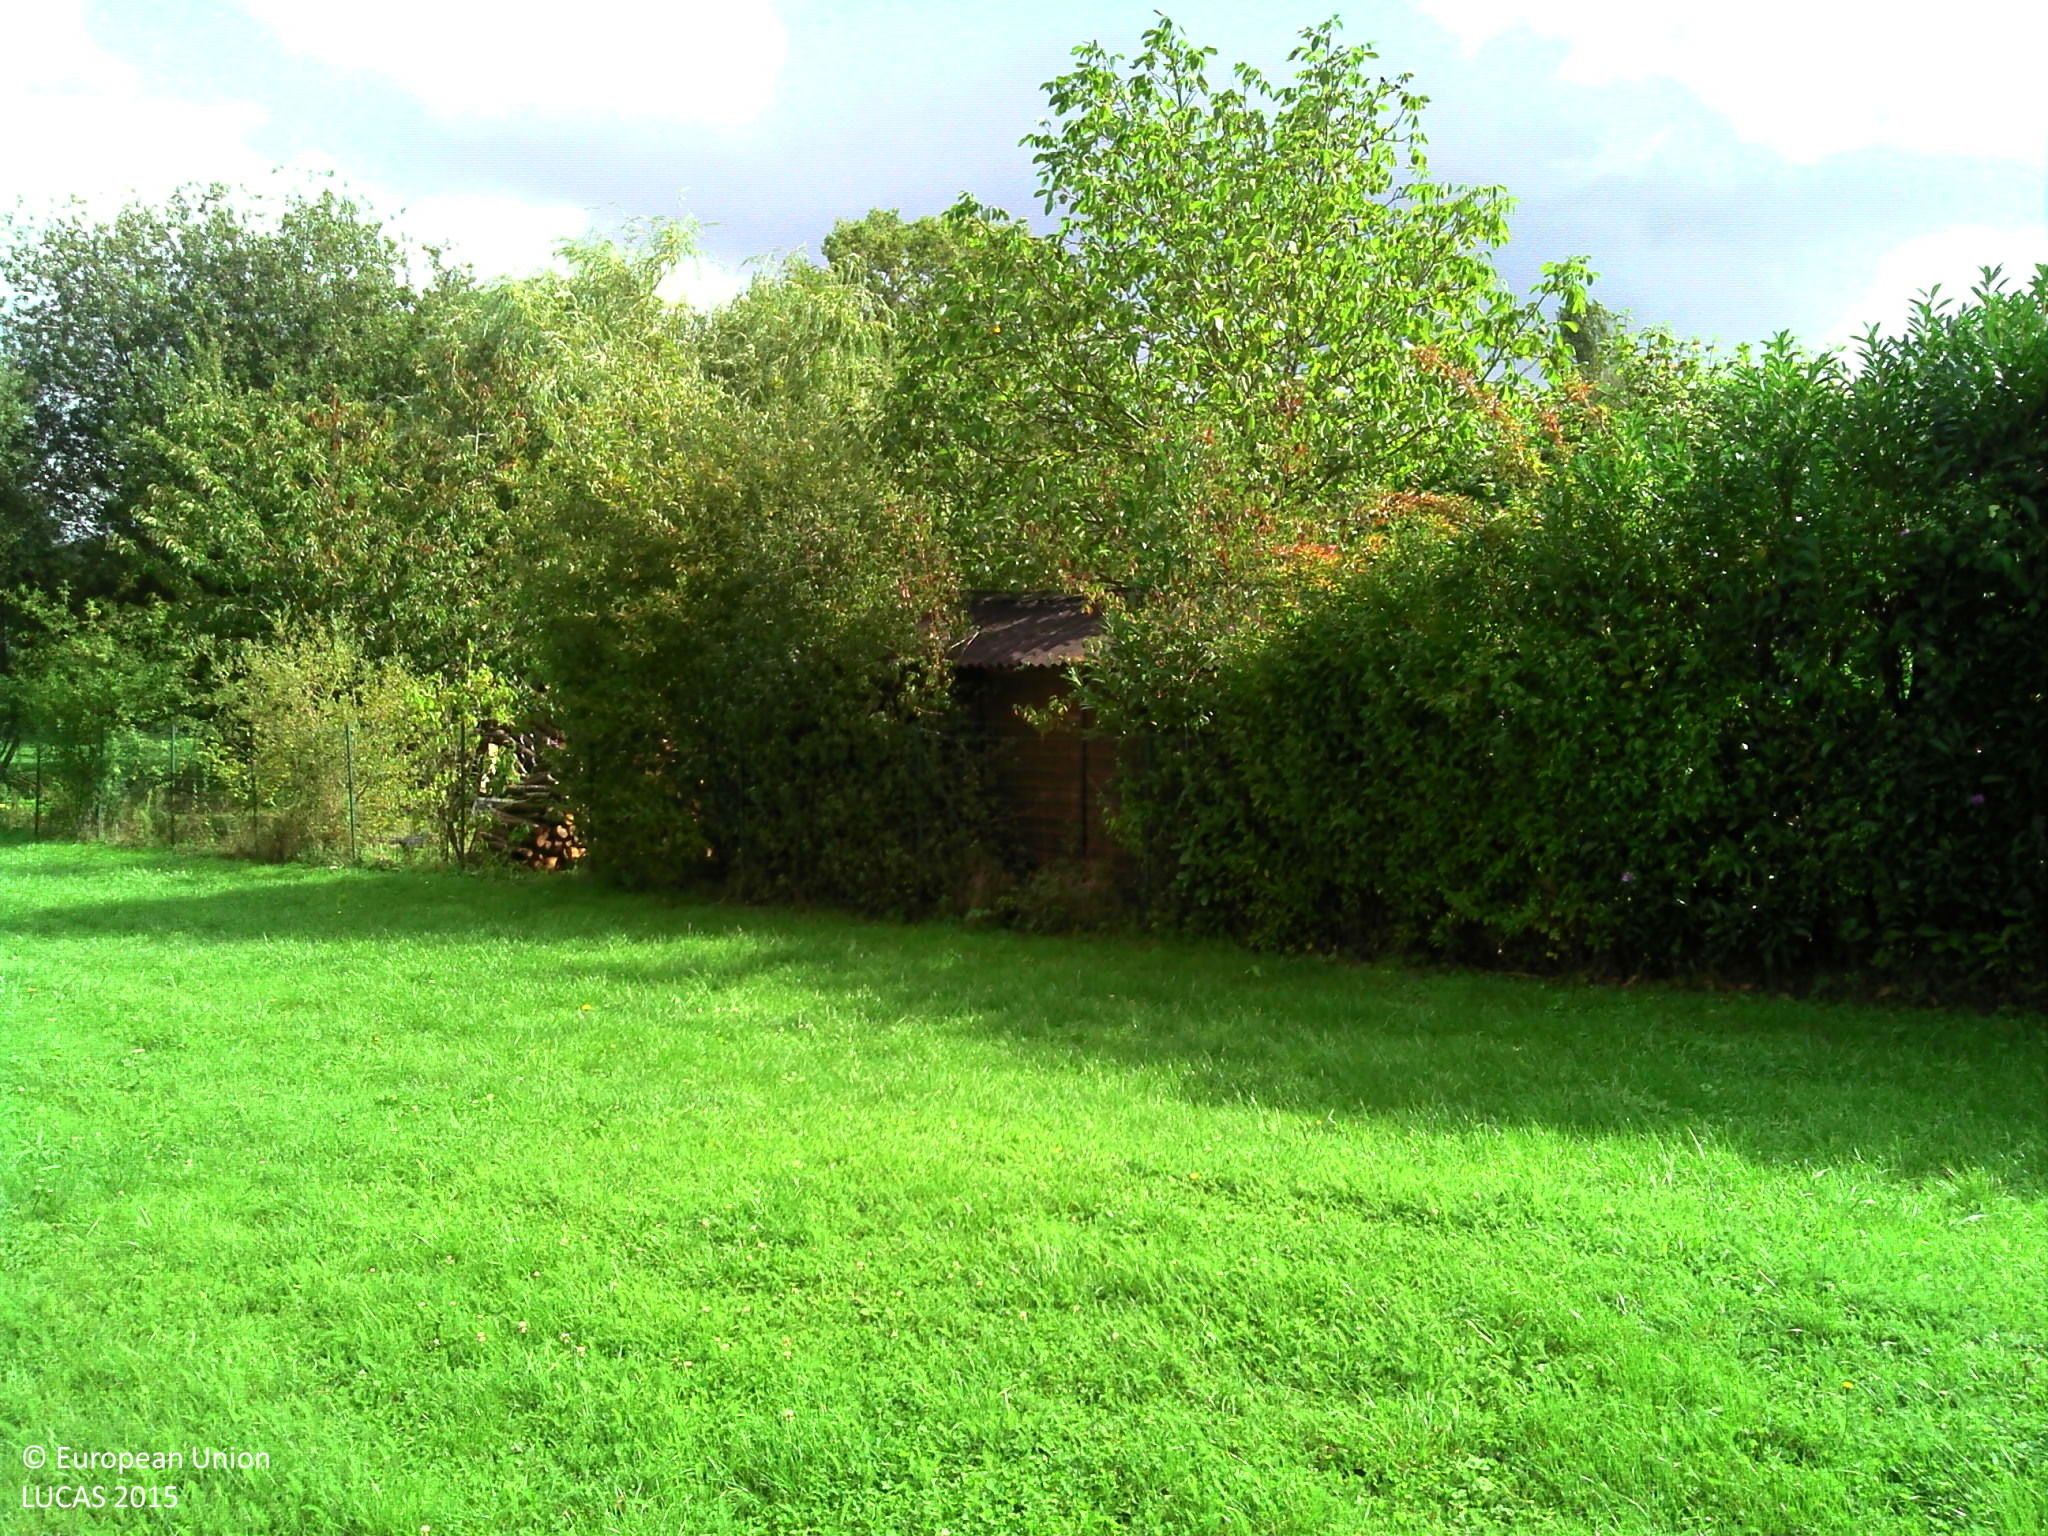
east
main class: Grassland
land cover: Grassland without tree/shrub cover
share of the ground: > 75 %
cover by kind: herbaceous plants 100 %
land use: Amenities, museums, leisure
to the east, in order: Grassland without tree/shrub cover; Artificial constructions in urban areas; Maize
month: September
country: FR
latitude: 48.4704
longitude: 2.9990
